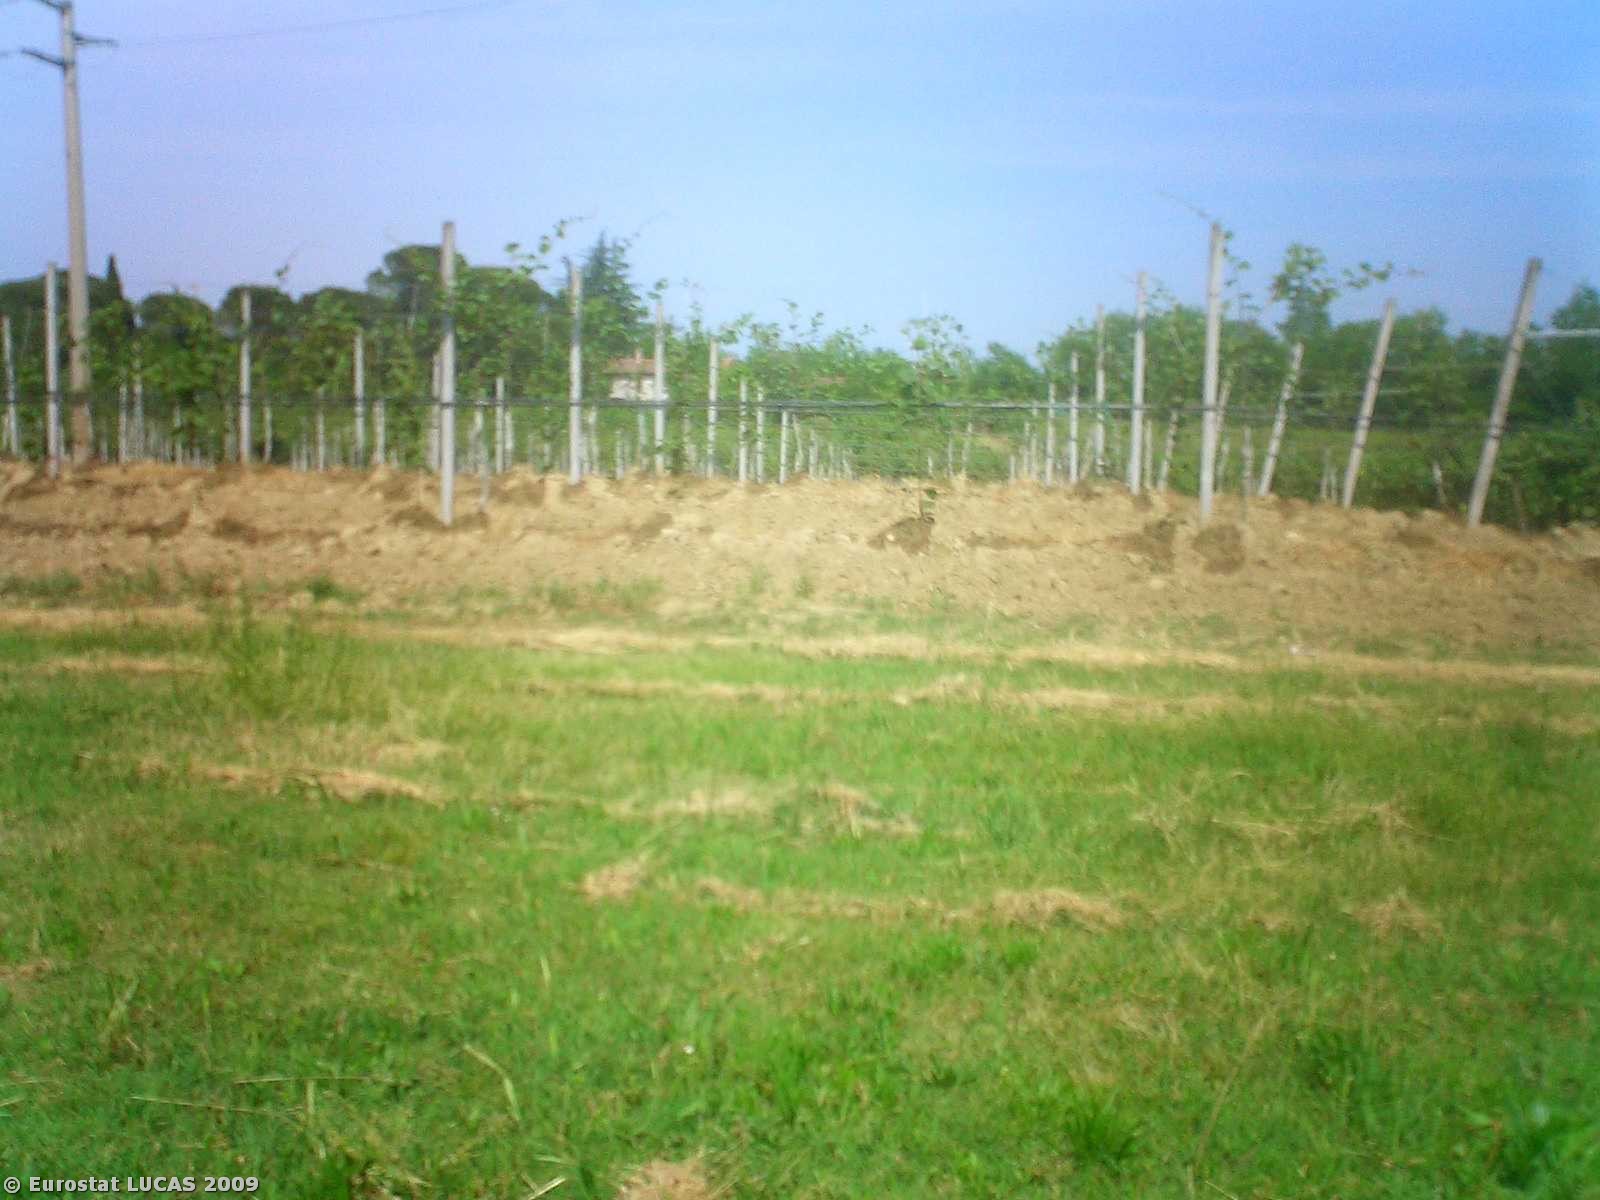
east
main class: Grassland
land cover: Grassland without tree/shrub cover
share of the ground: > 75 %
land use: Agriculture (excluding fallow land and kitchen gardens)
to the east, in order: Grassland without tree/shrub cover; Other fruit trees and berries; Grassland with sparse tree/shrub cover; Abandoned hedges; Ditches and canals; Abandoned hedges; Other fruit trees and berries; Grassland with sparse tree/shrub cover; Tracks; Other fruit trees and berries; Grassland with sparse tree/shrub cover
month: May
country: IT
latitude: 44.2256
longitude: 11.8610
